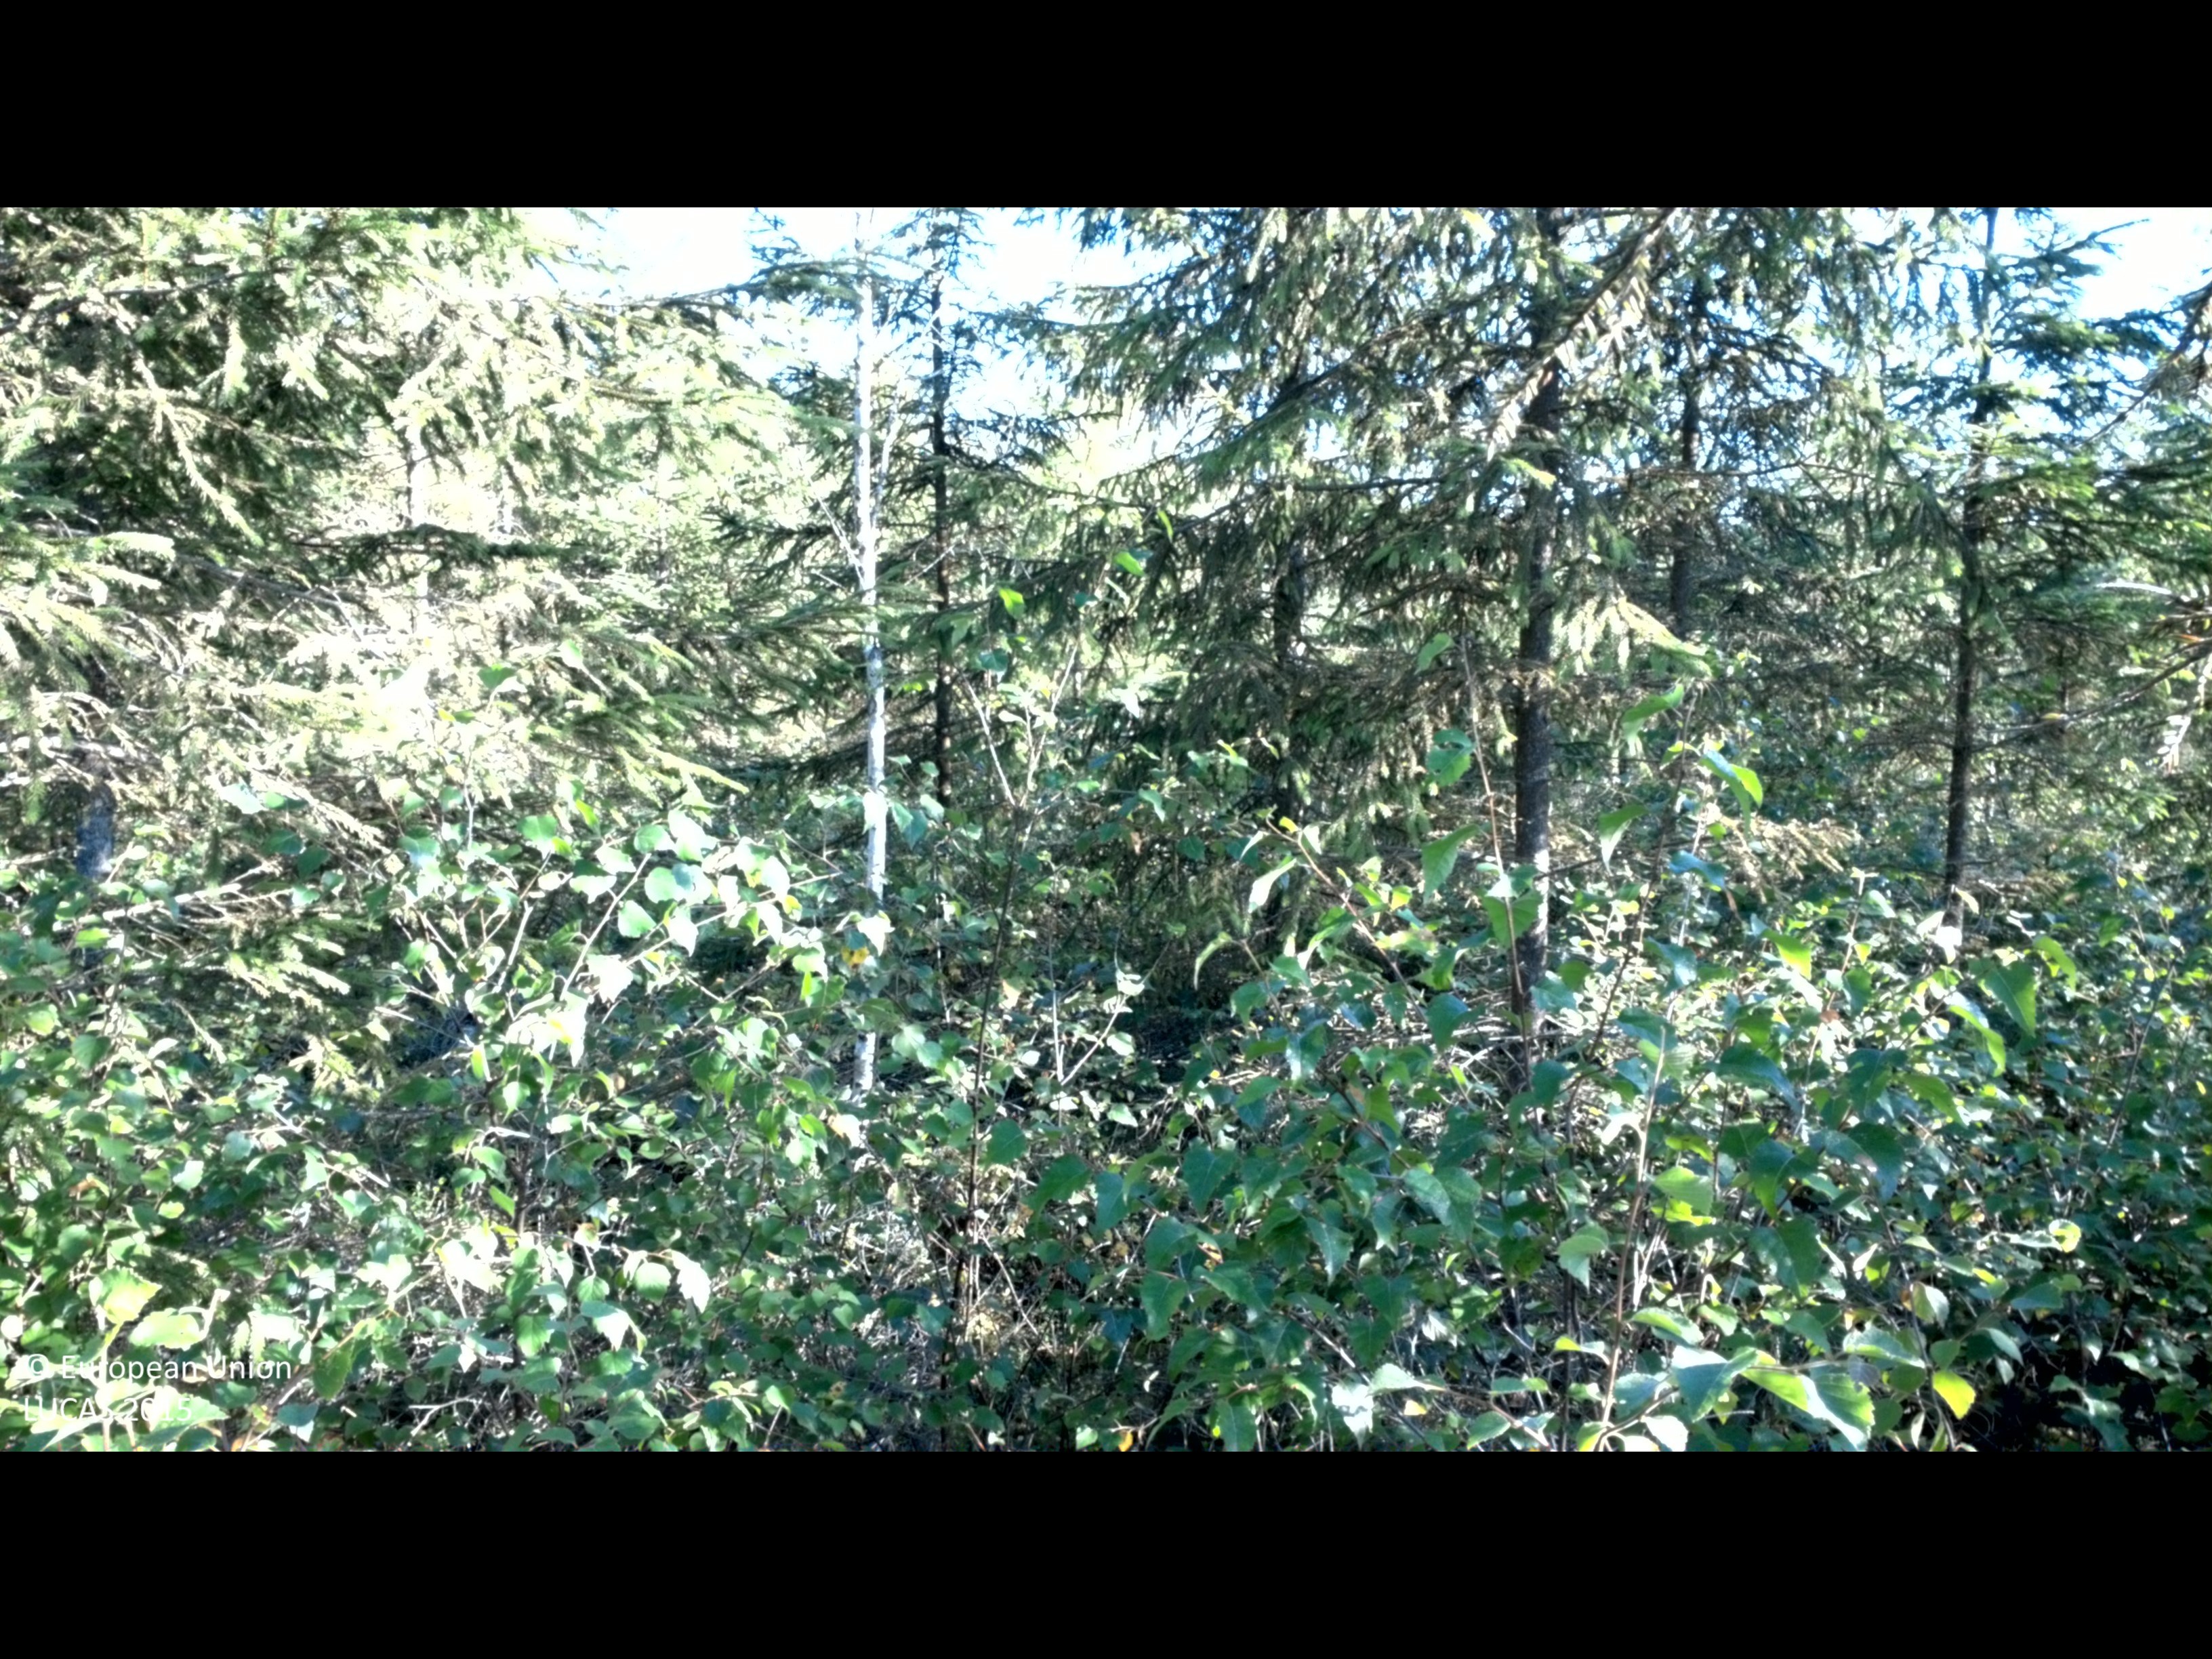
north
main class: Woodland
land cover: Spruce dominated mixed woodland
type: boreal forest
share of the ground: 50 - 75 %
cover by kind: coniferous forest trees 45 %, broadleaved forest trees 30 %, shrubs 25 %
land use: Forestry
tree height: > 5 m
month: August
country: SE
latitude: 56.9567
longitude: 13.2358
